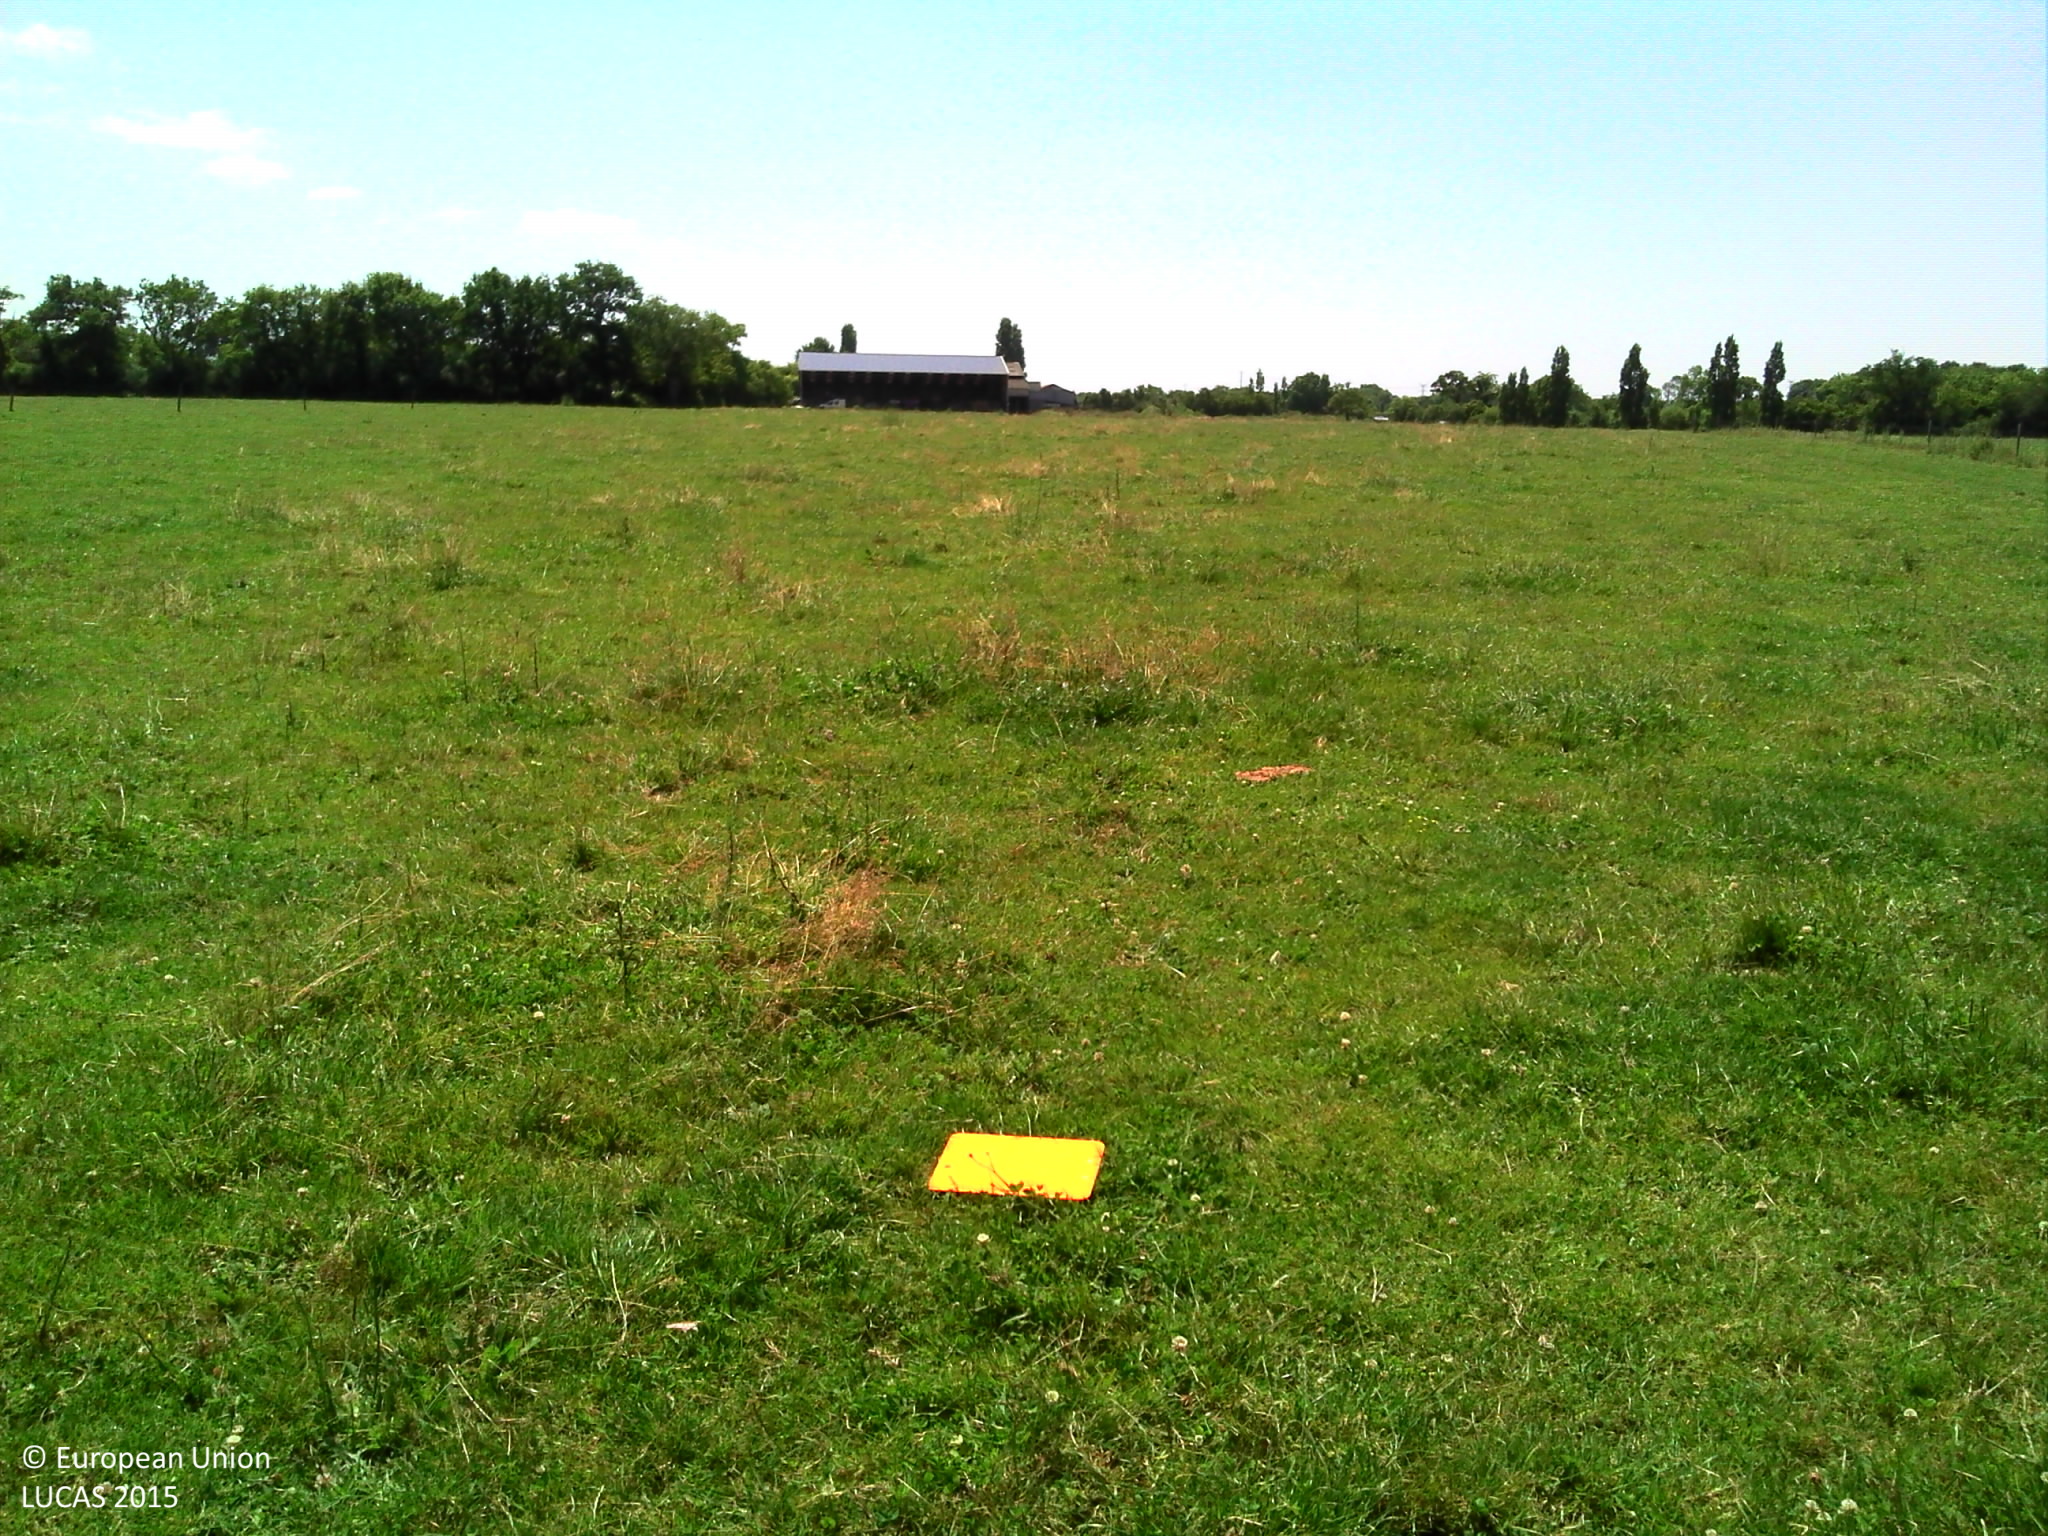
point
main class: Cropland
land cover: Temporary grasslands
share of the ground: > 75 %
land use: Agriculture (excluding fallow land and kitchen gardens)
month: June
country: FR
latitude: 47.0540
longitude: -1.8537
